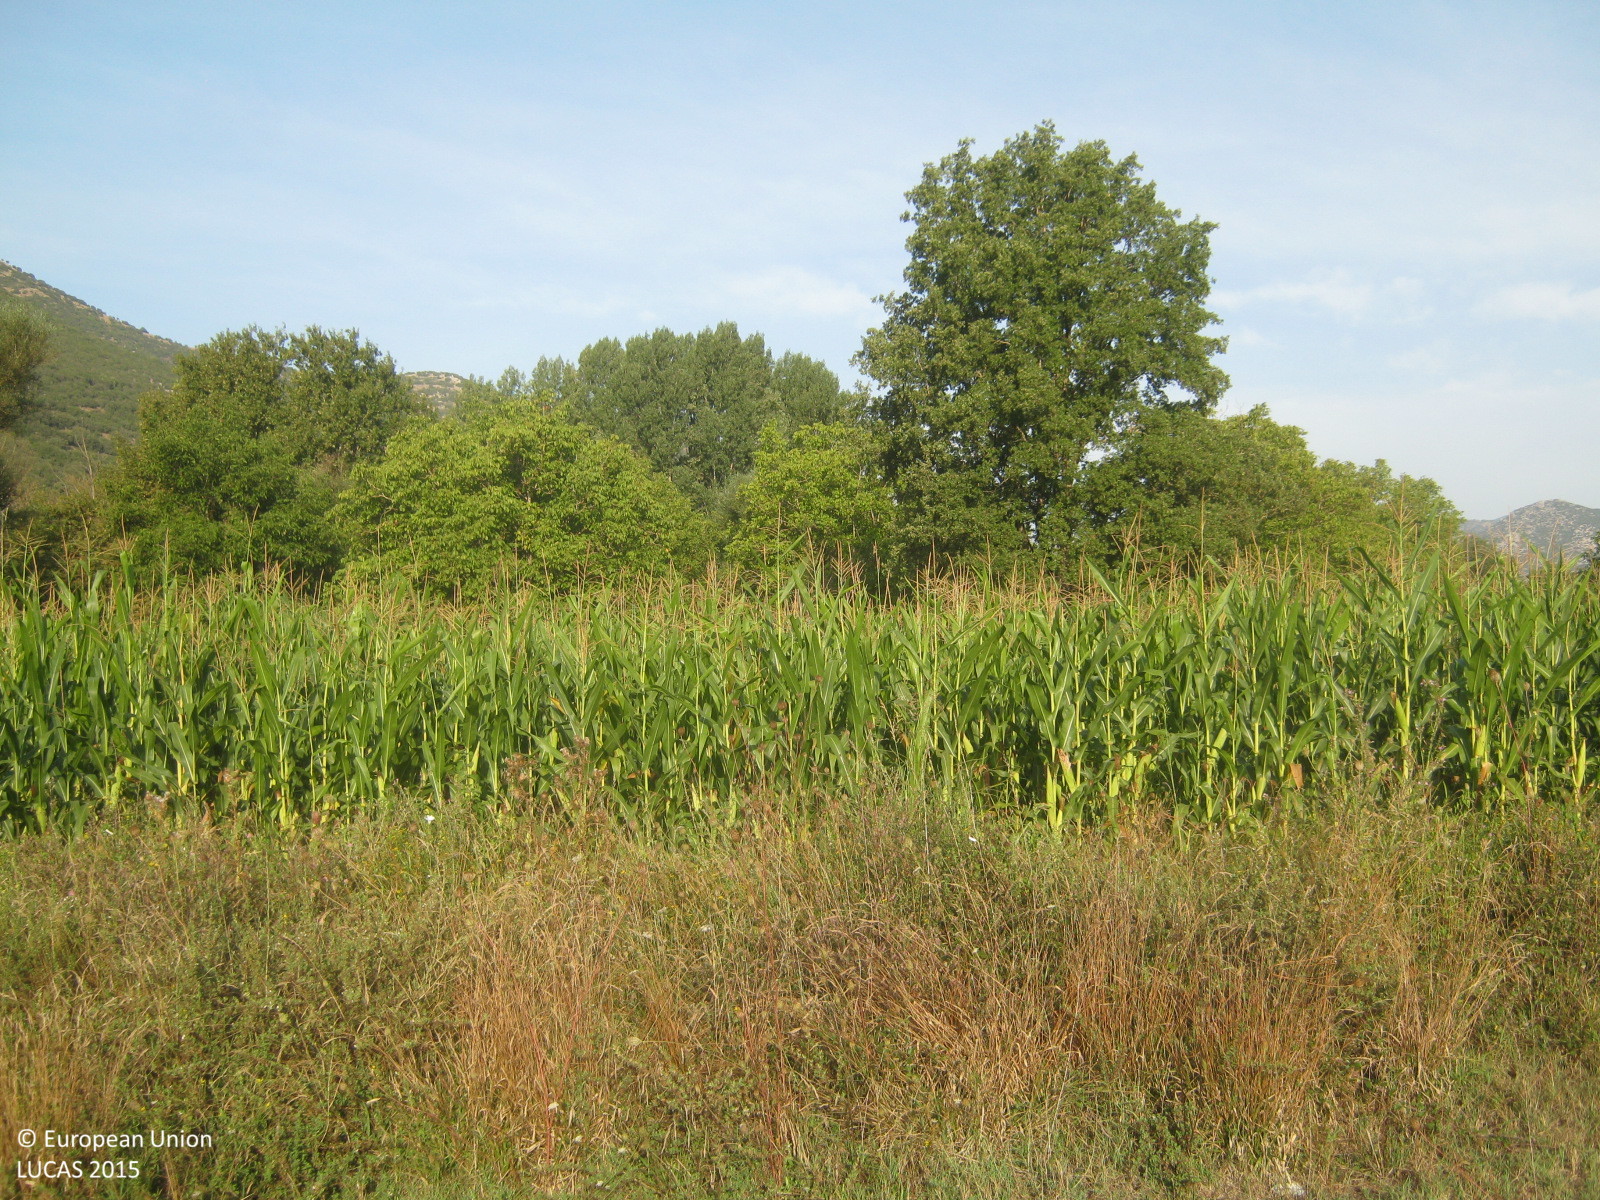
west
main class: Grassland
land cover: Spontaneously vegetated surfaces
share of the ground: > 75 %
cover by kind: herbaceous plants 90 %, shrubs 5 %, unconsolidated bare surface 5 %
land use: Fallow land
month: September
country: GR
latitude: 37.8821
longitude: 22.1424
